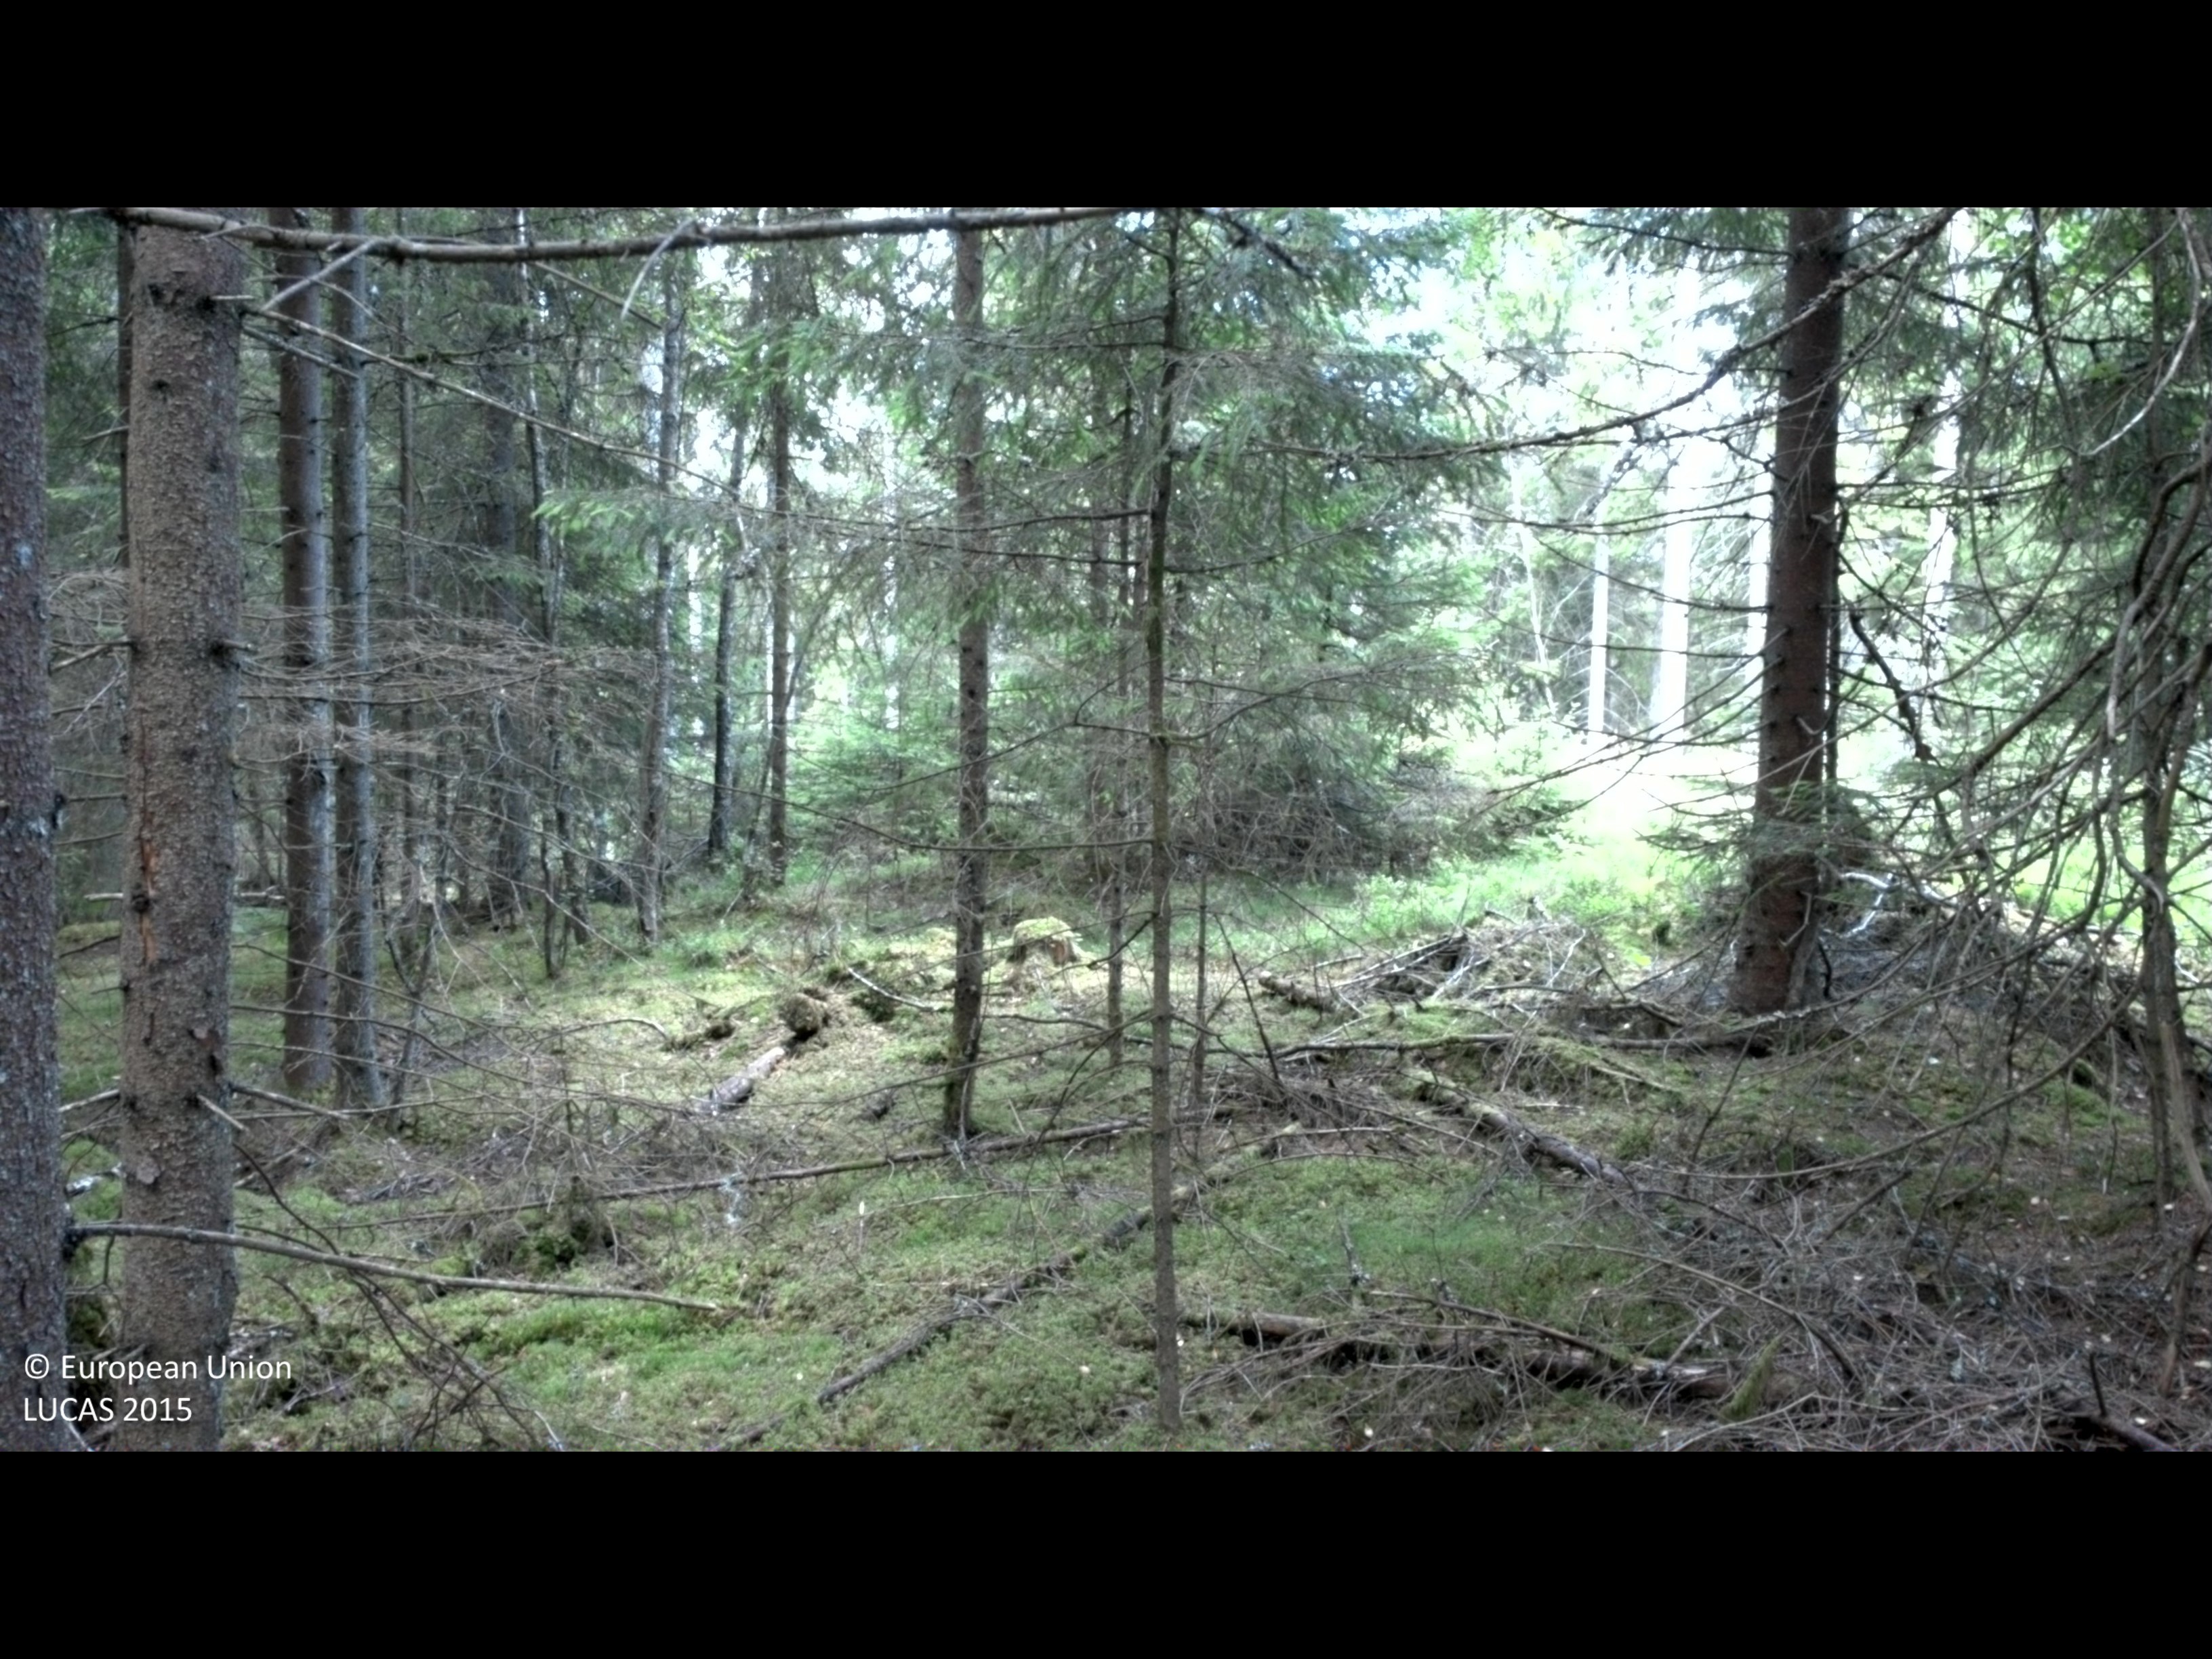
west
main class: Woodland
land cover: Spruce dominated coniferous woodland
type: boreal forest
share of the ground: > 75 %
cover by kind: coniferous forest trees 80 %, shrubs 10 %, herbaceous plants 5 %, lichens and mosses 5 %
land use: Forestry
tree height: > 5 m
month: July
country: SE
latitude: 56.5270
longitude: 13.8174
